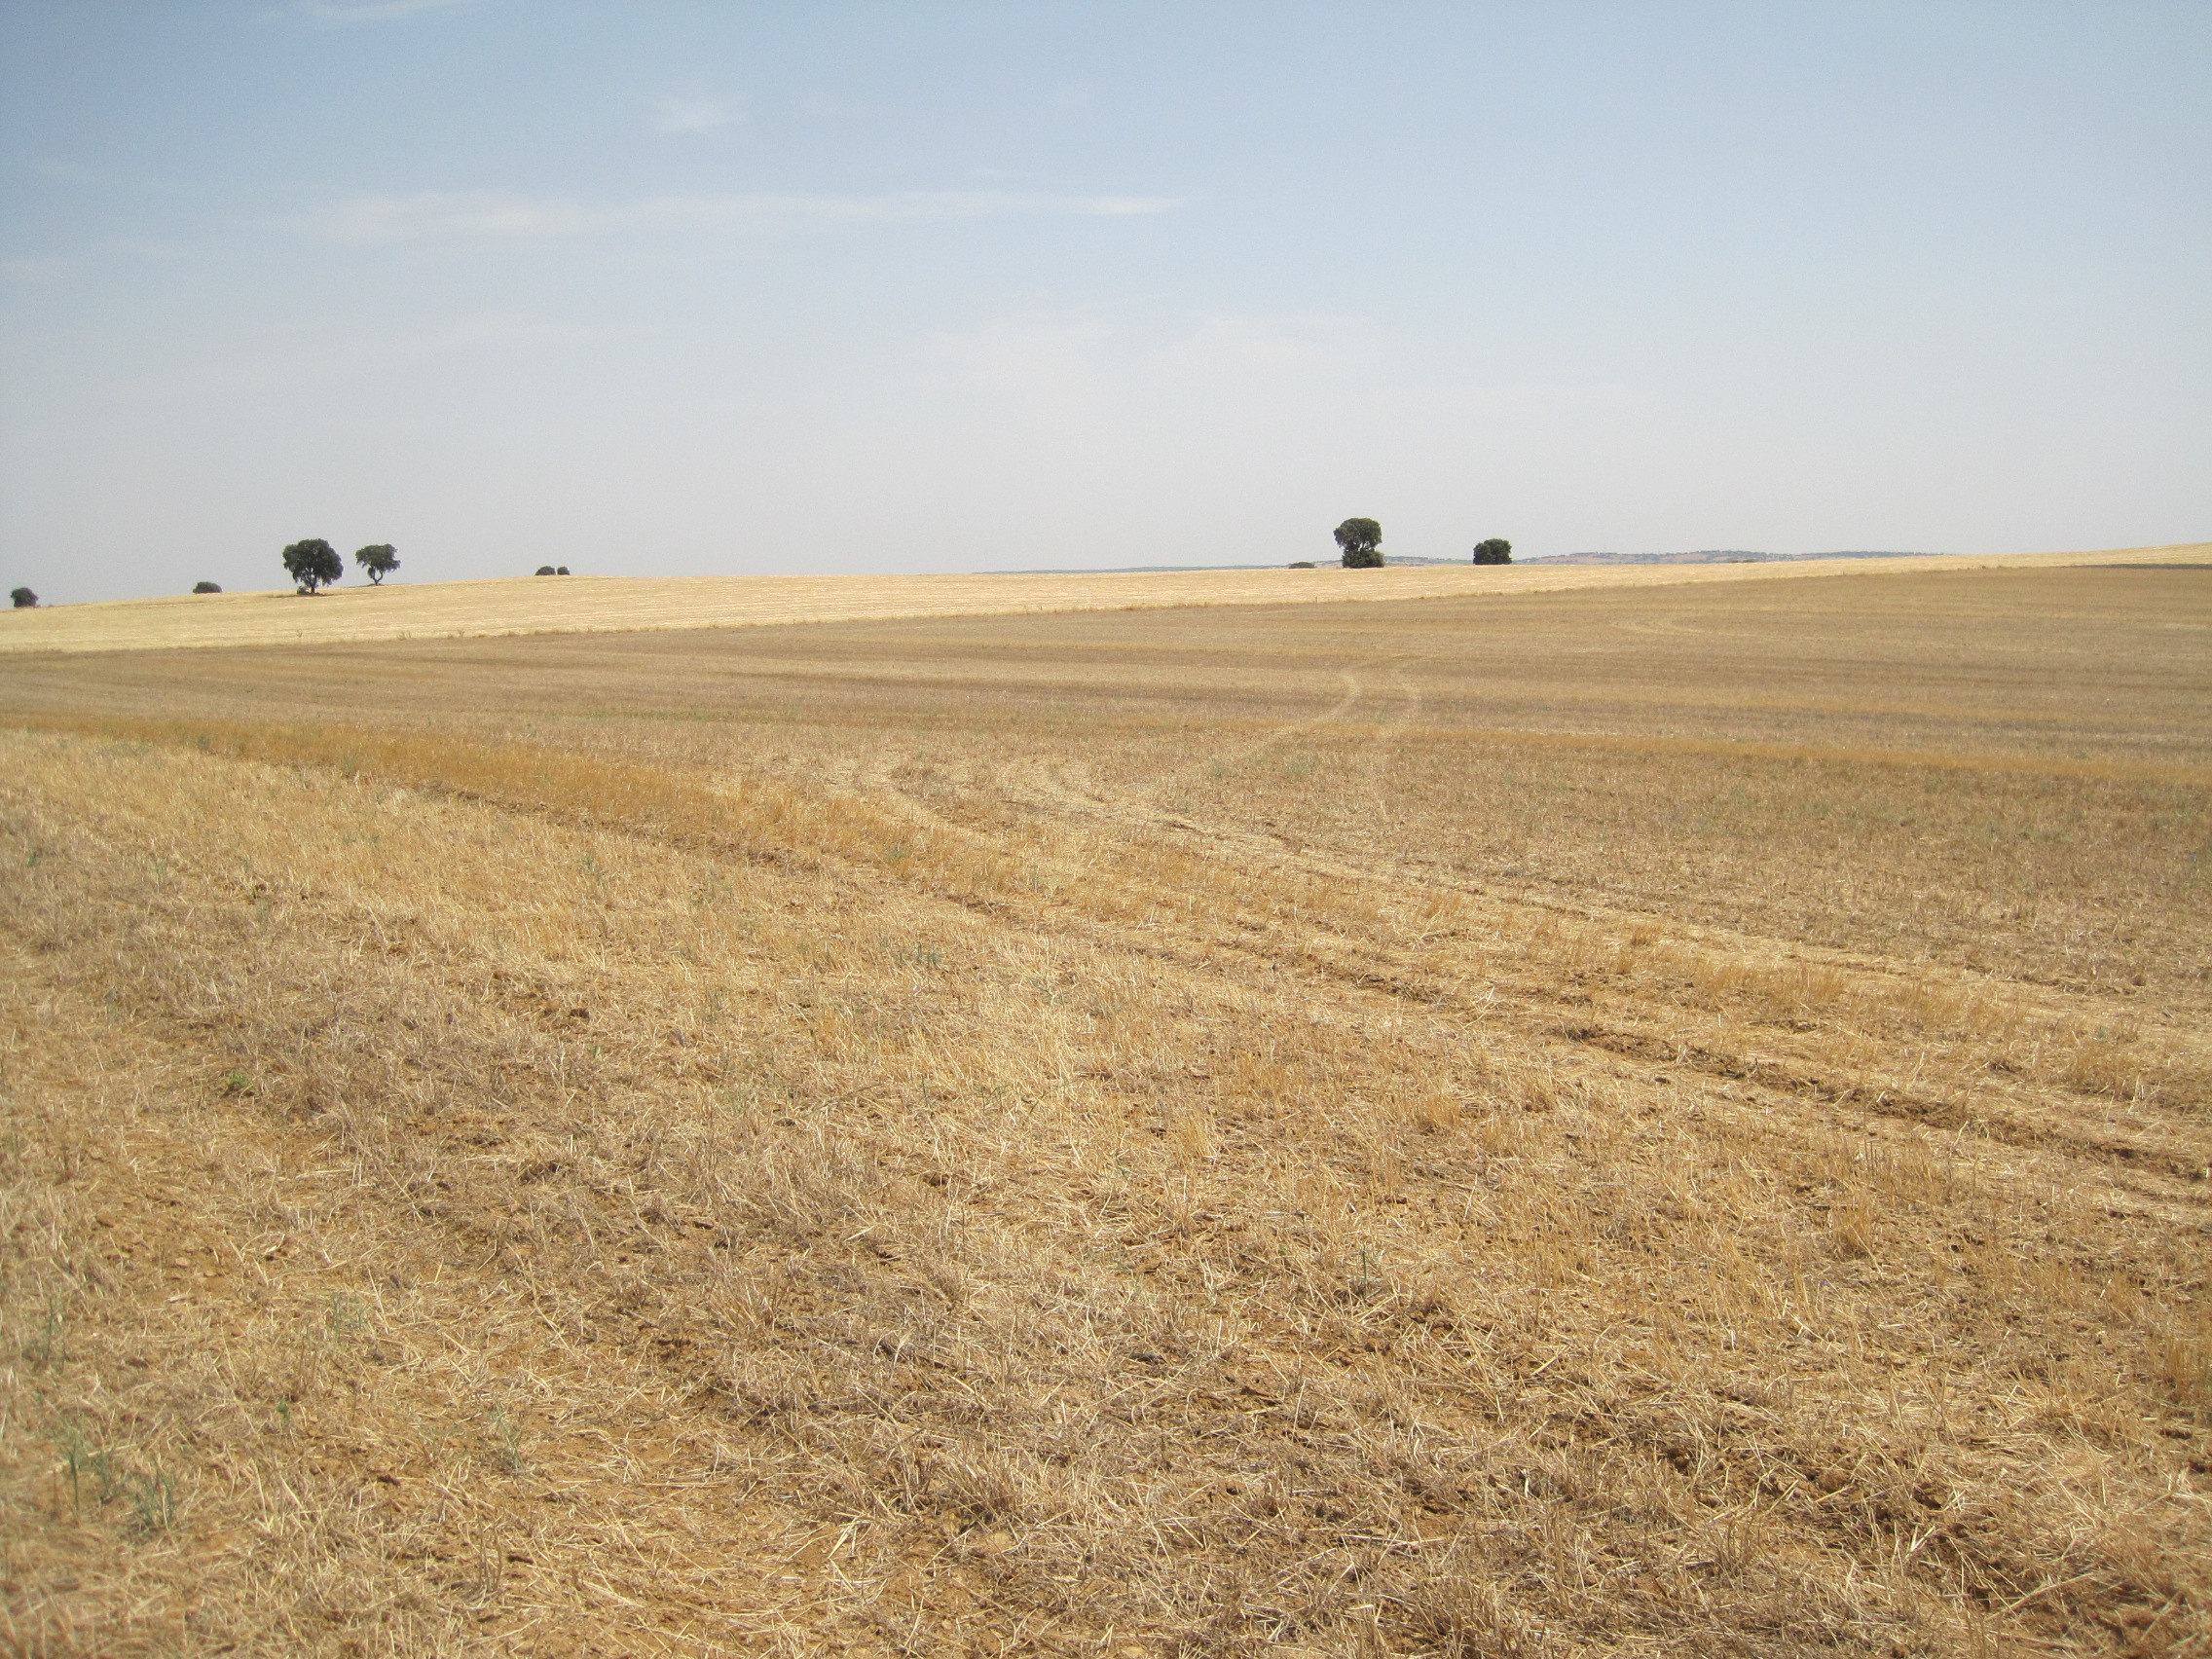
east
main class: Cropland
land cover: Dry pulses
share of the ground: < 10 %
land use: Agriculture (excluding fallow land and kitchen gardens)
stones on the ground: 10 - 25 %
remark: Harvested field
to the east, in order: Dry pulses; Grass margins; Common wheat
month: July
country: ES
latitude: 41.7544
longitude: -5.5645
